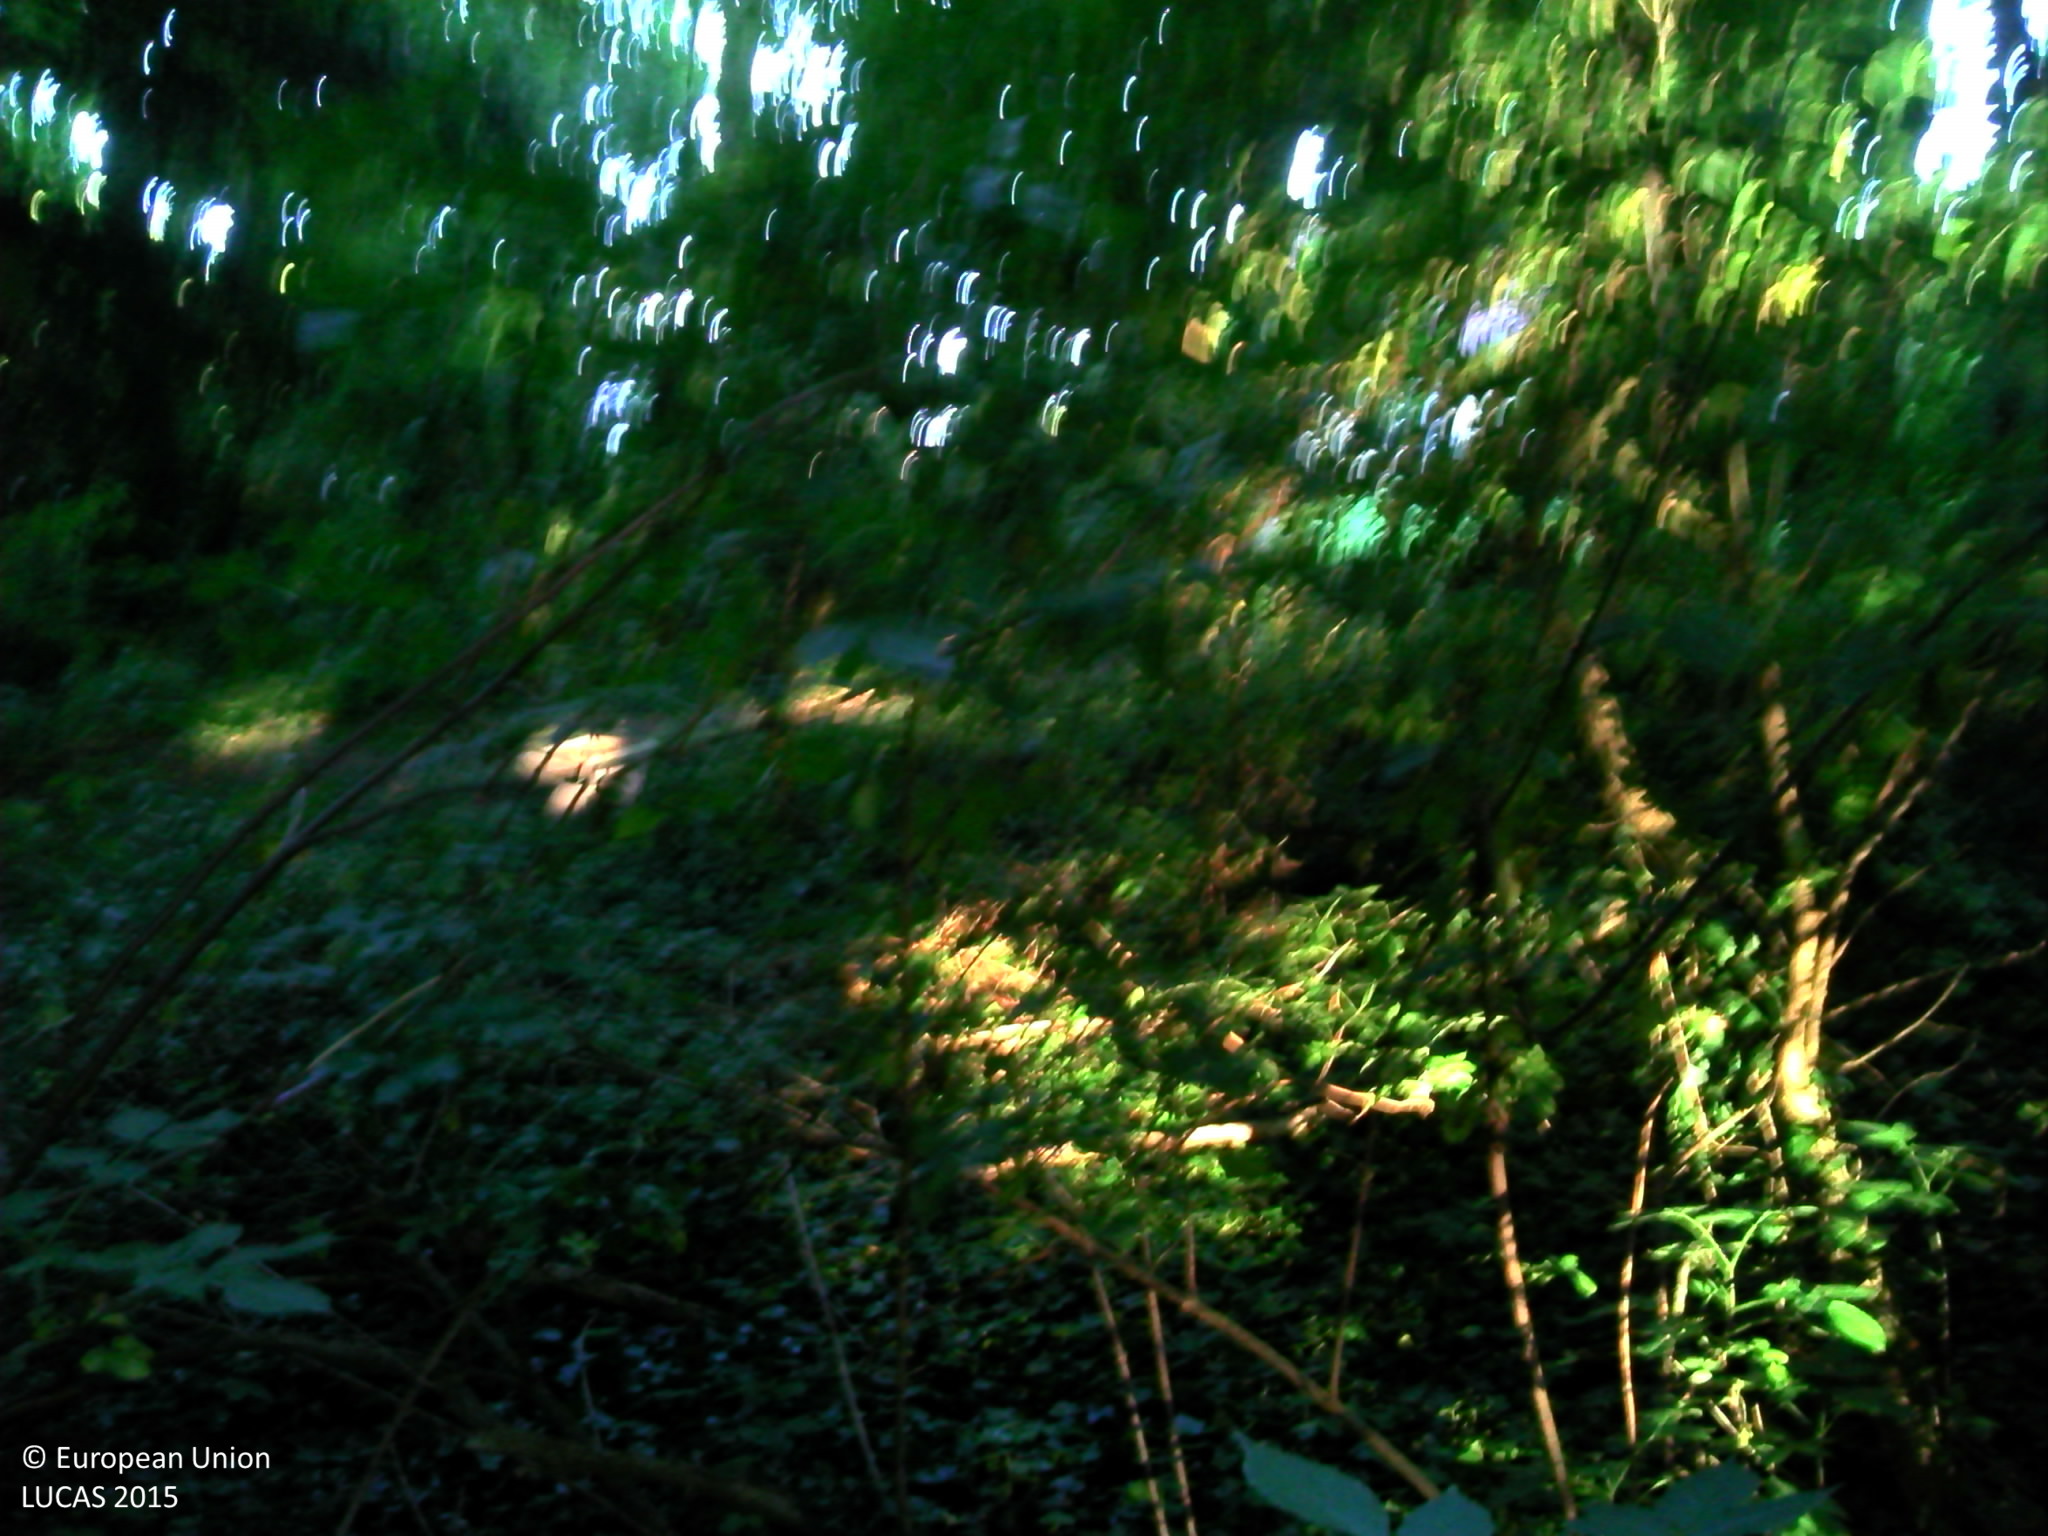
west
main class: Woodland
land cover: Broadleaved woodland
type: mesophytic deciduous forest
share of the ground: > 75 %
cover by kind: broadleaved forest trees 90 %, shrubs 5 %, herbaceous plants 5 %
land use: Forestry
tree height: > 5 m
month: July
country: FR
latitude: 49.1032
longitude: -0.2655
